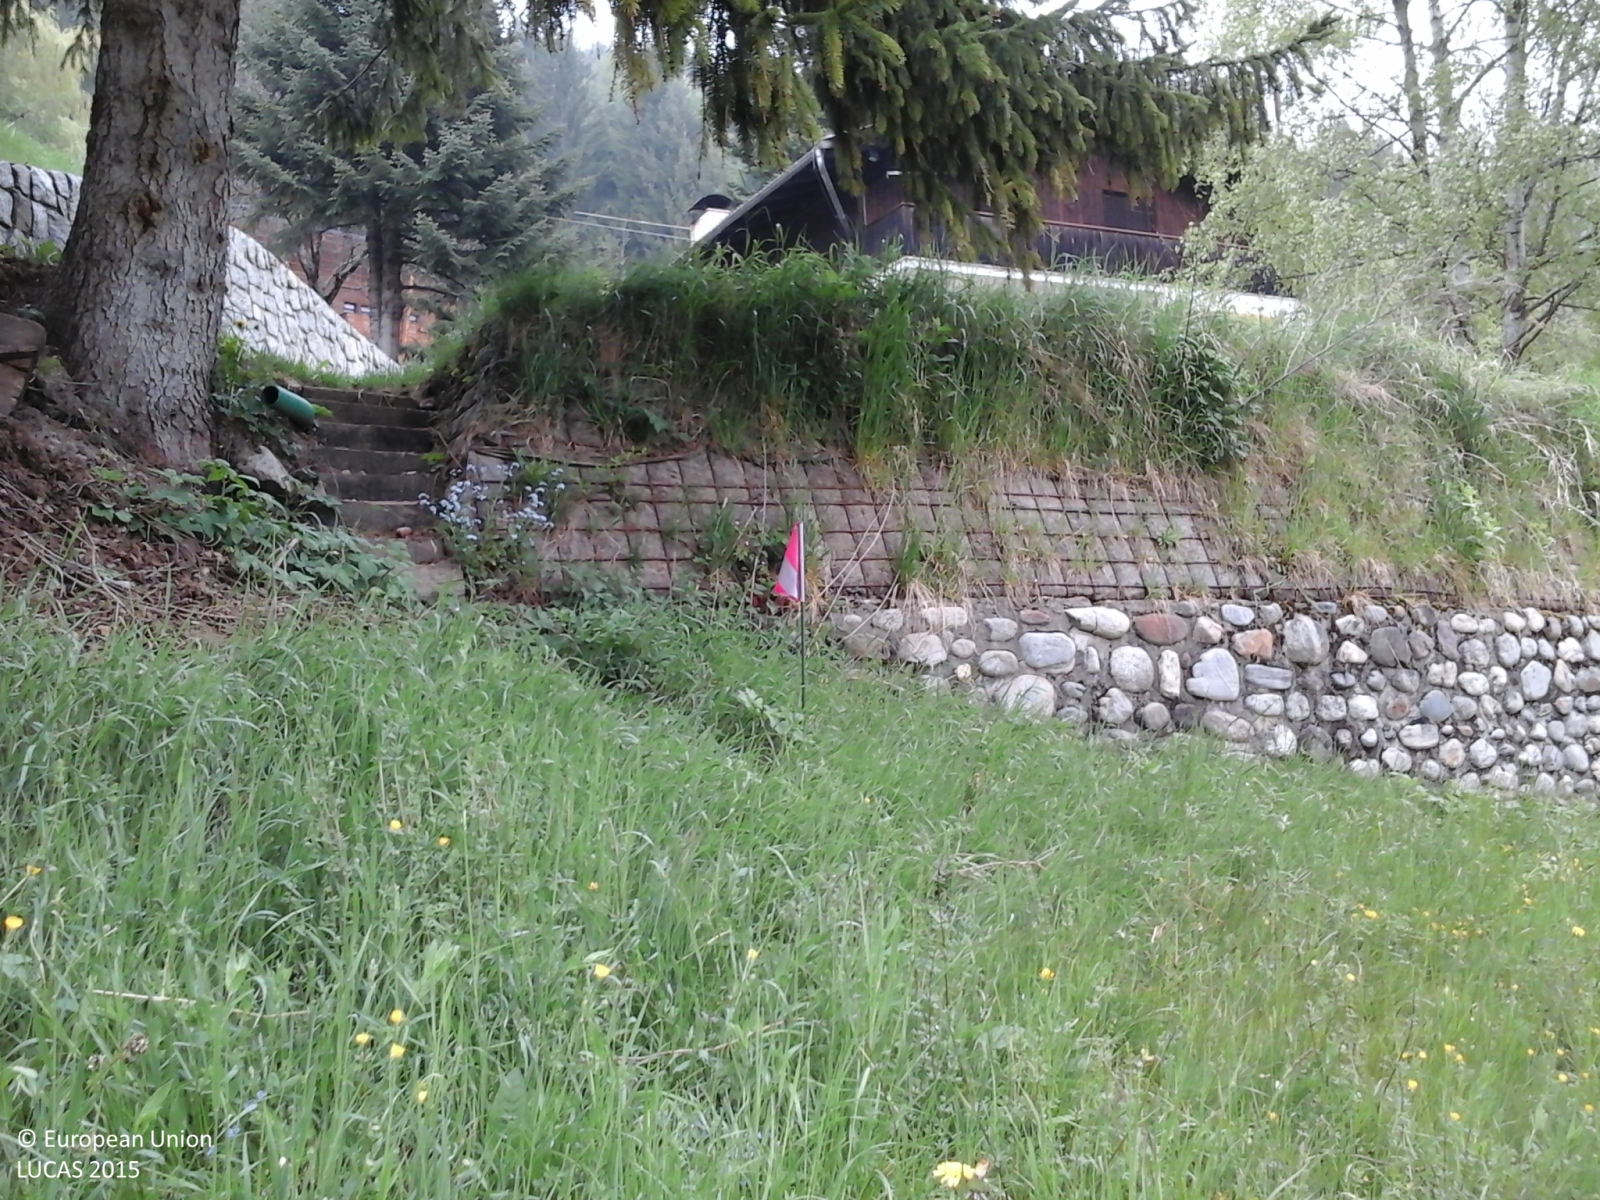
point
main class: Grassland
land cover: Grassland without tree/shrub cover
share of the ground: > 75 %
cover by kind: herbaceous plants 100 %
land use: Agriculture (excluding fallow land and kitchen gardens)
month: May
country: IT
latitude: 46.5433
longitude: 11.1332
